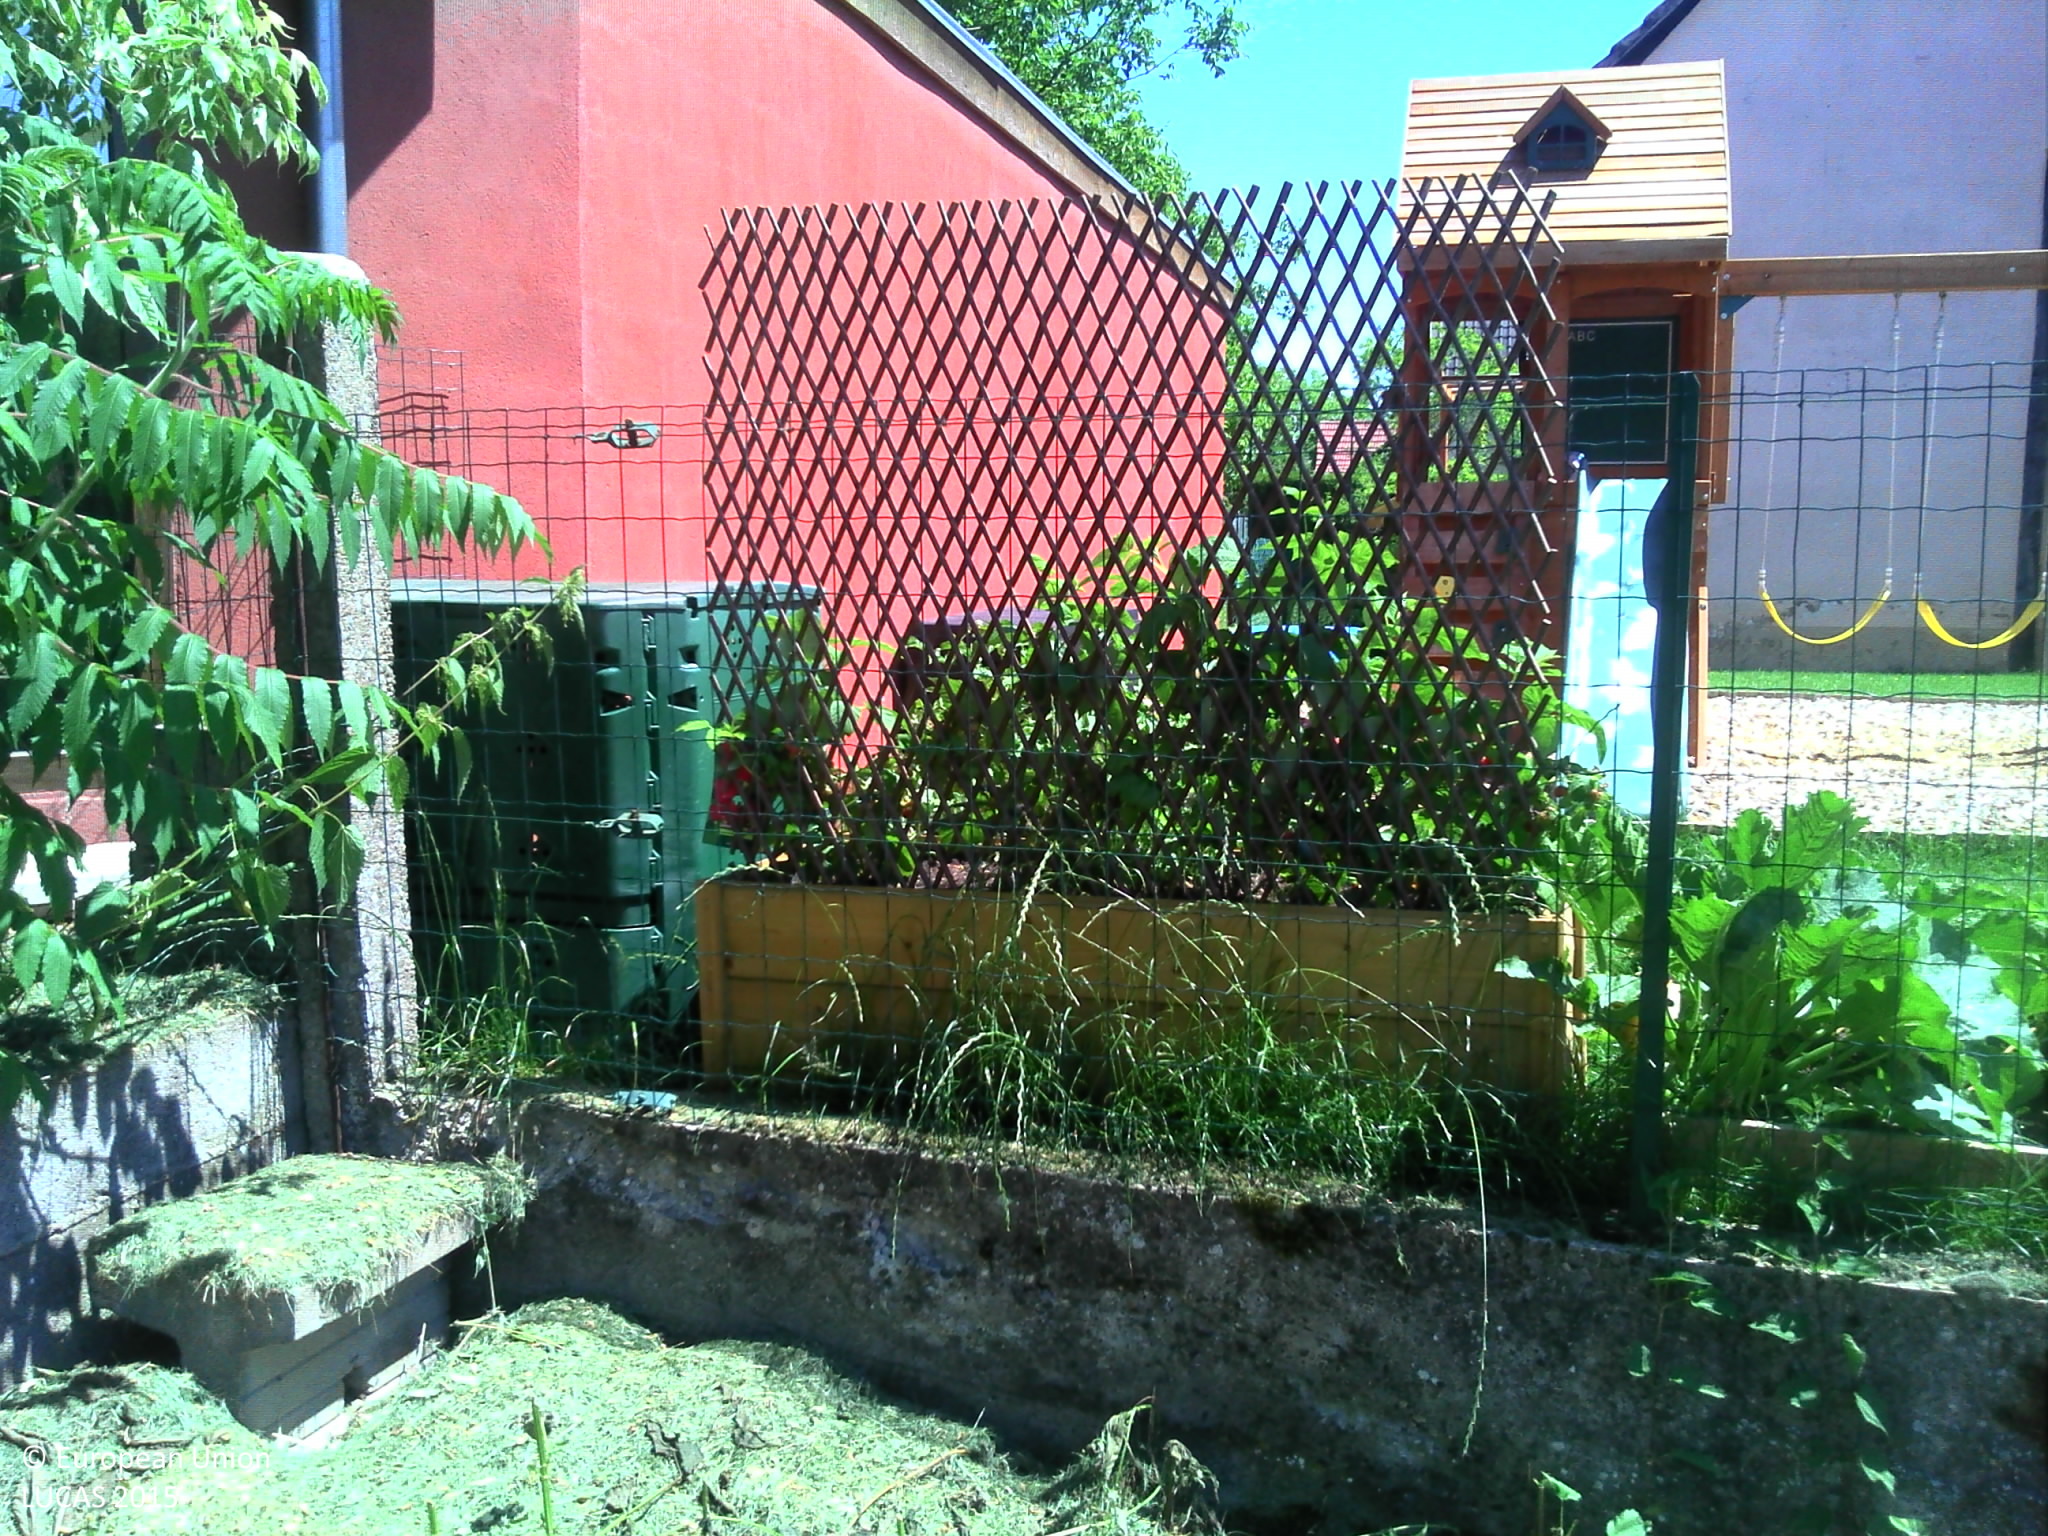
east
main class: Grassland
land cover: Grassland with sparse tree/shrub cover
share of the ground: > 75 %
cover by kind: herbaceous plants 95 %, broadleaved forest trees 5 %
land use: Residential
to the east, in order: Grassland with sparse tree/shrub cover; Artificial constructions in urban areas
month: June
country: FR
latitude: 48.4682
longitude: 7.6340
